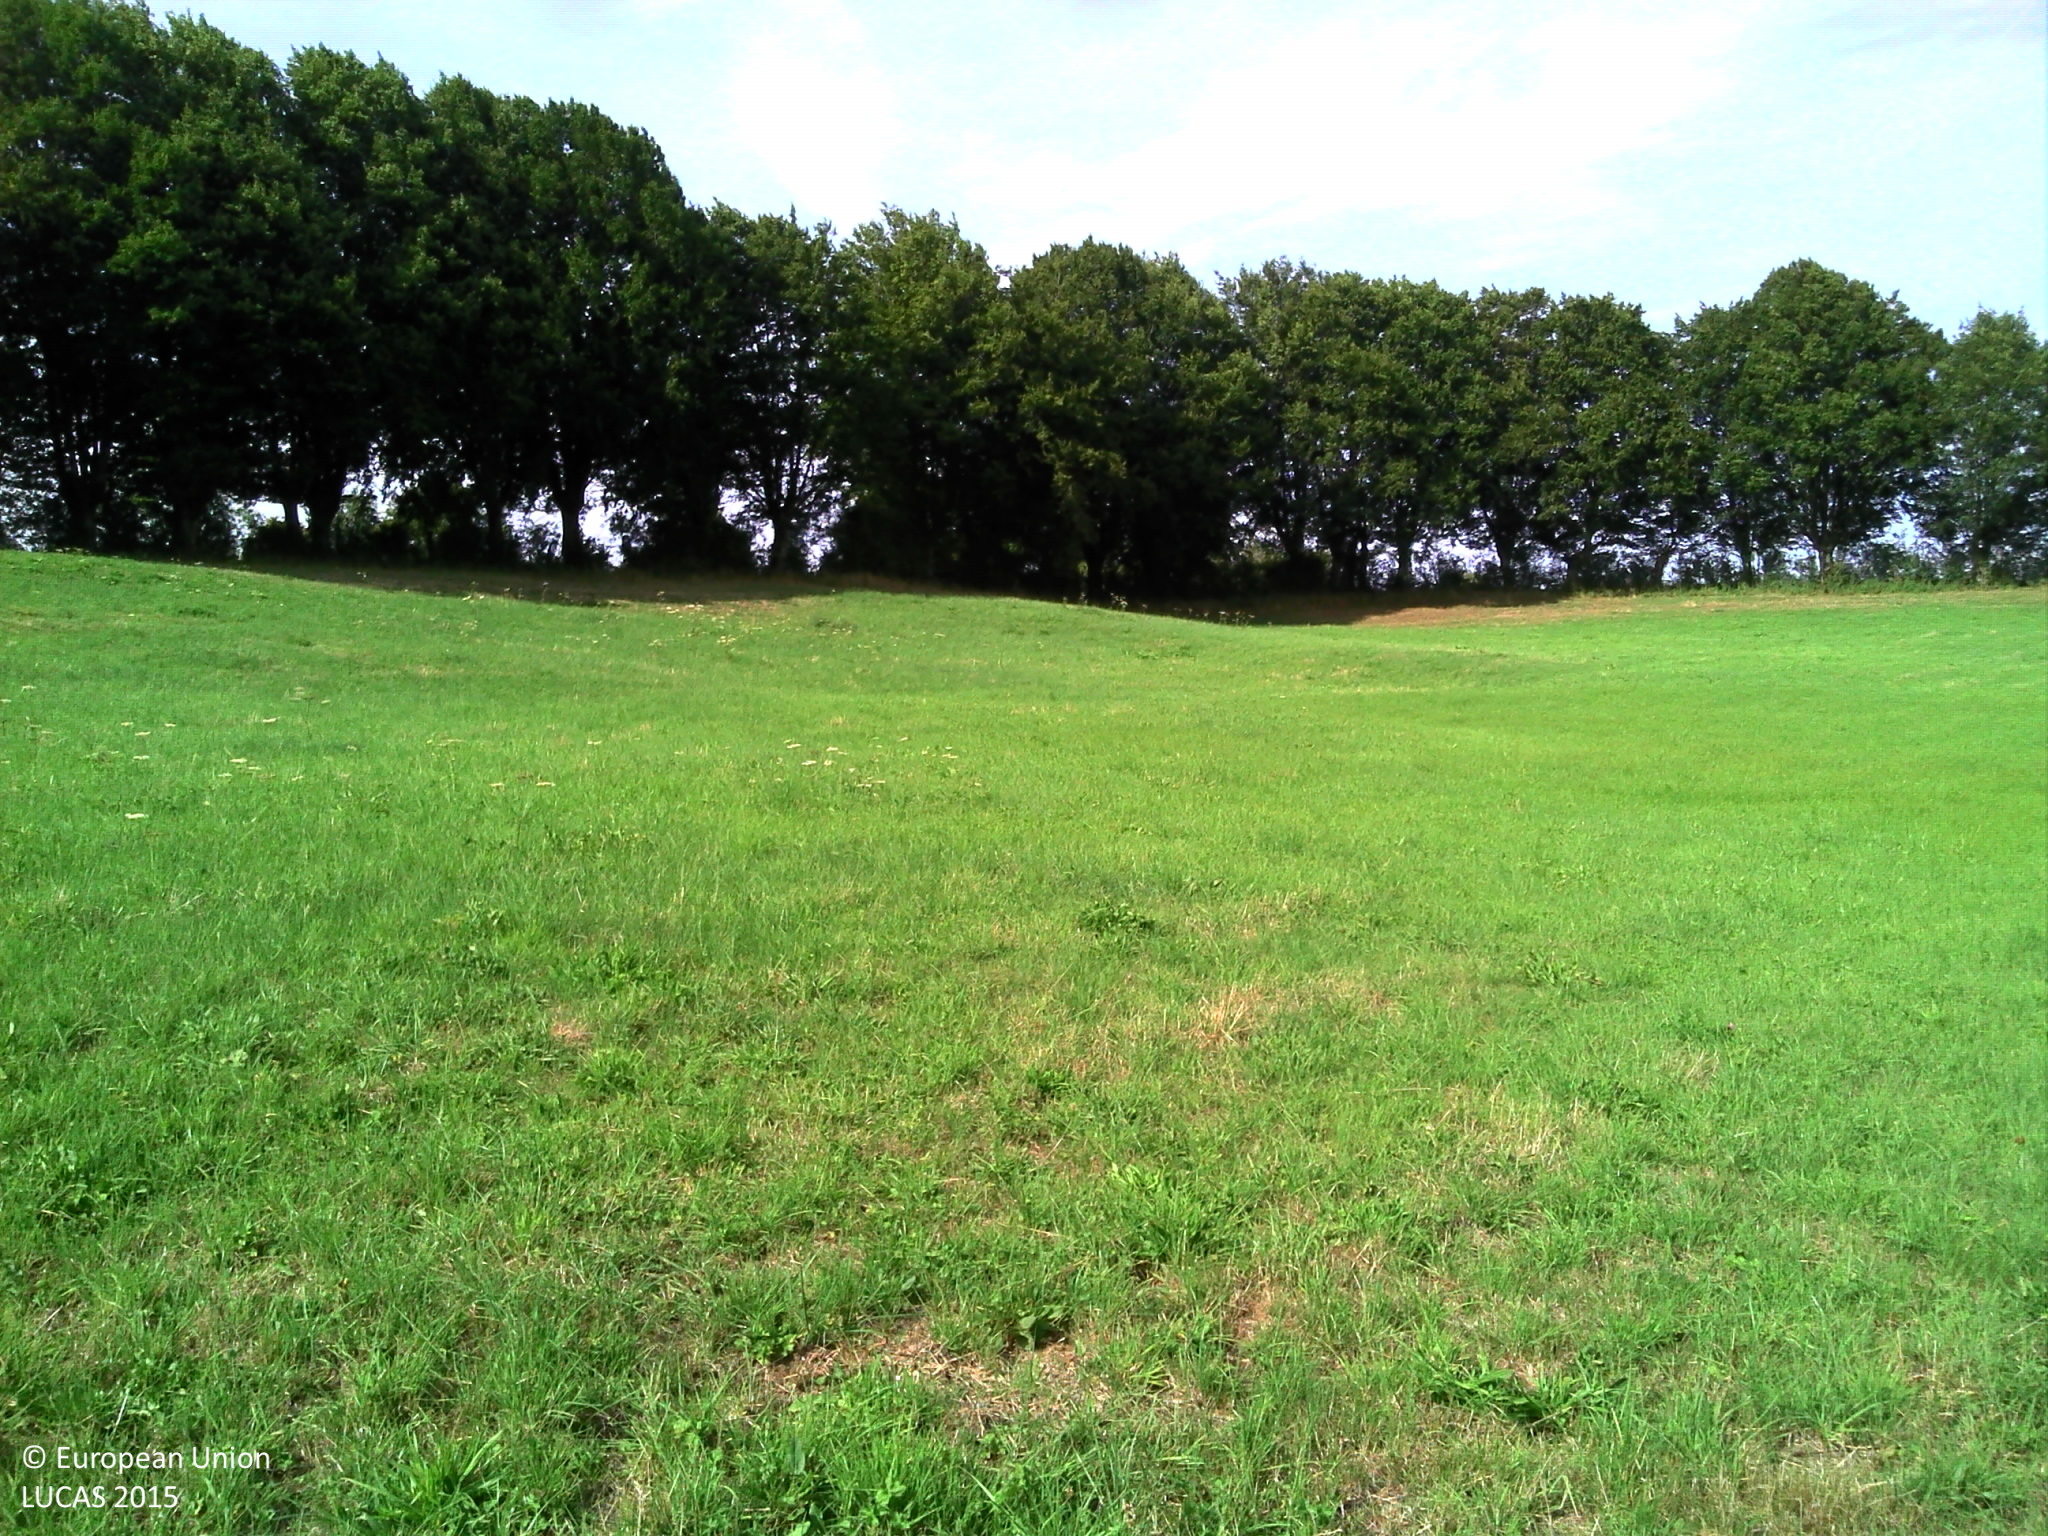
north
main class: Grassland
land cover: Grassland without tree/shrub cover
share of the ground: > 75 %
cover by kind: herbaceous plants 95 %, lichens and mosses 5 %
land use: Agriculture (excluding fallow land and kitchen gardens)
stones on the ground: < 10 %
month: August
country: FR
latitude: 50.0788
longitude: 3.9715
